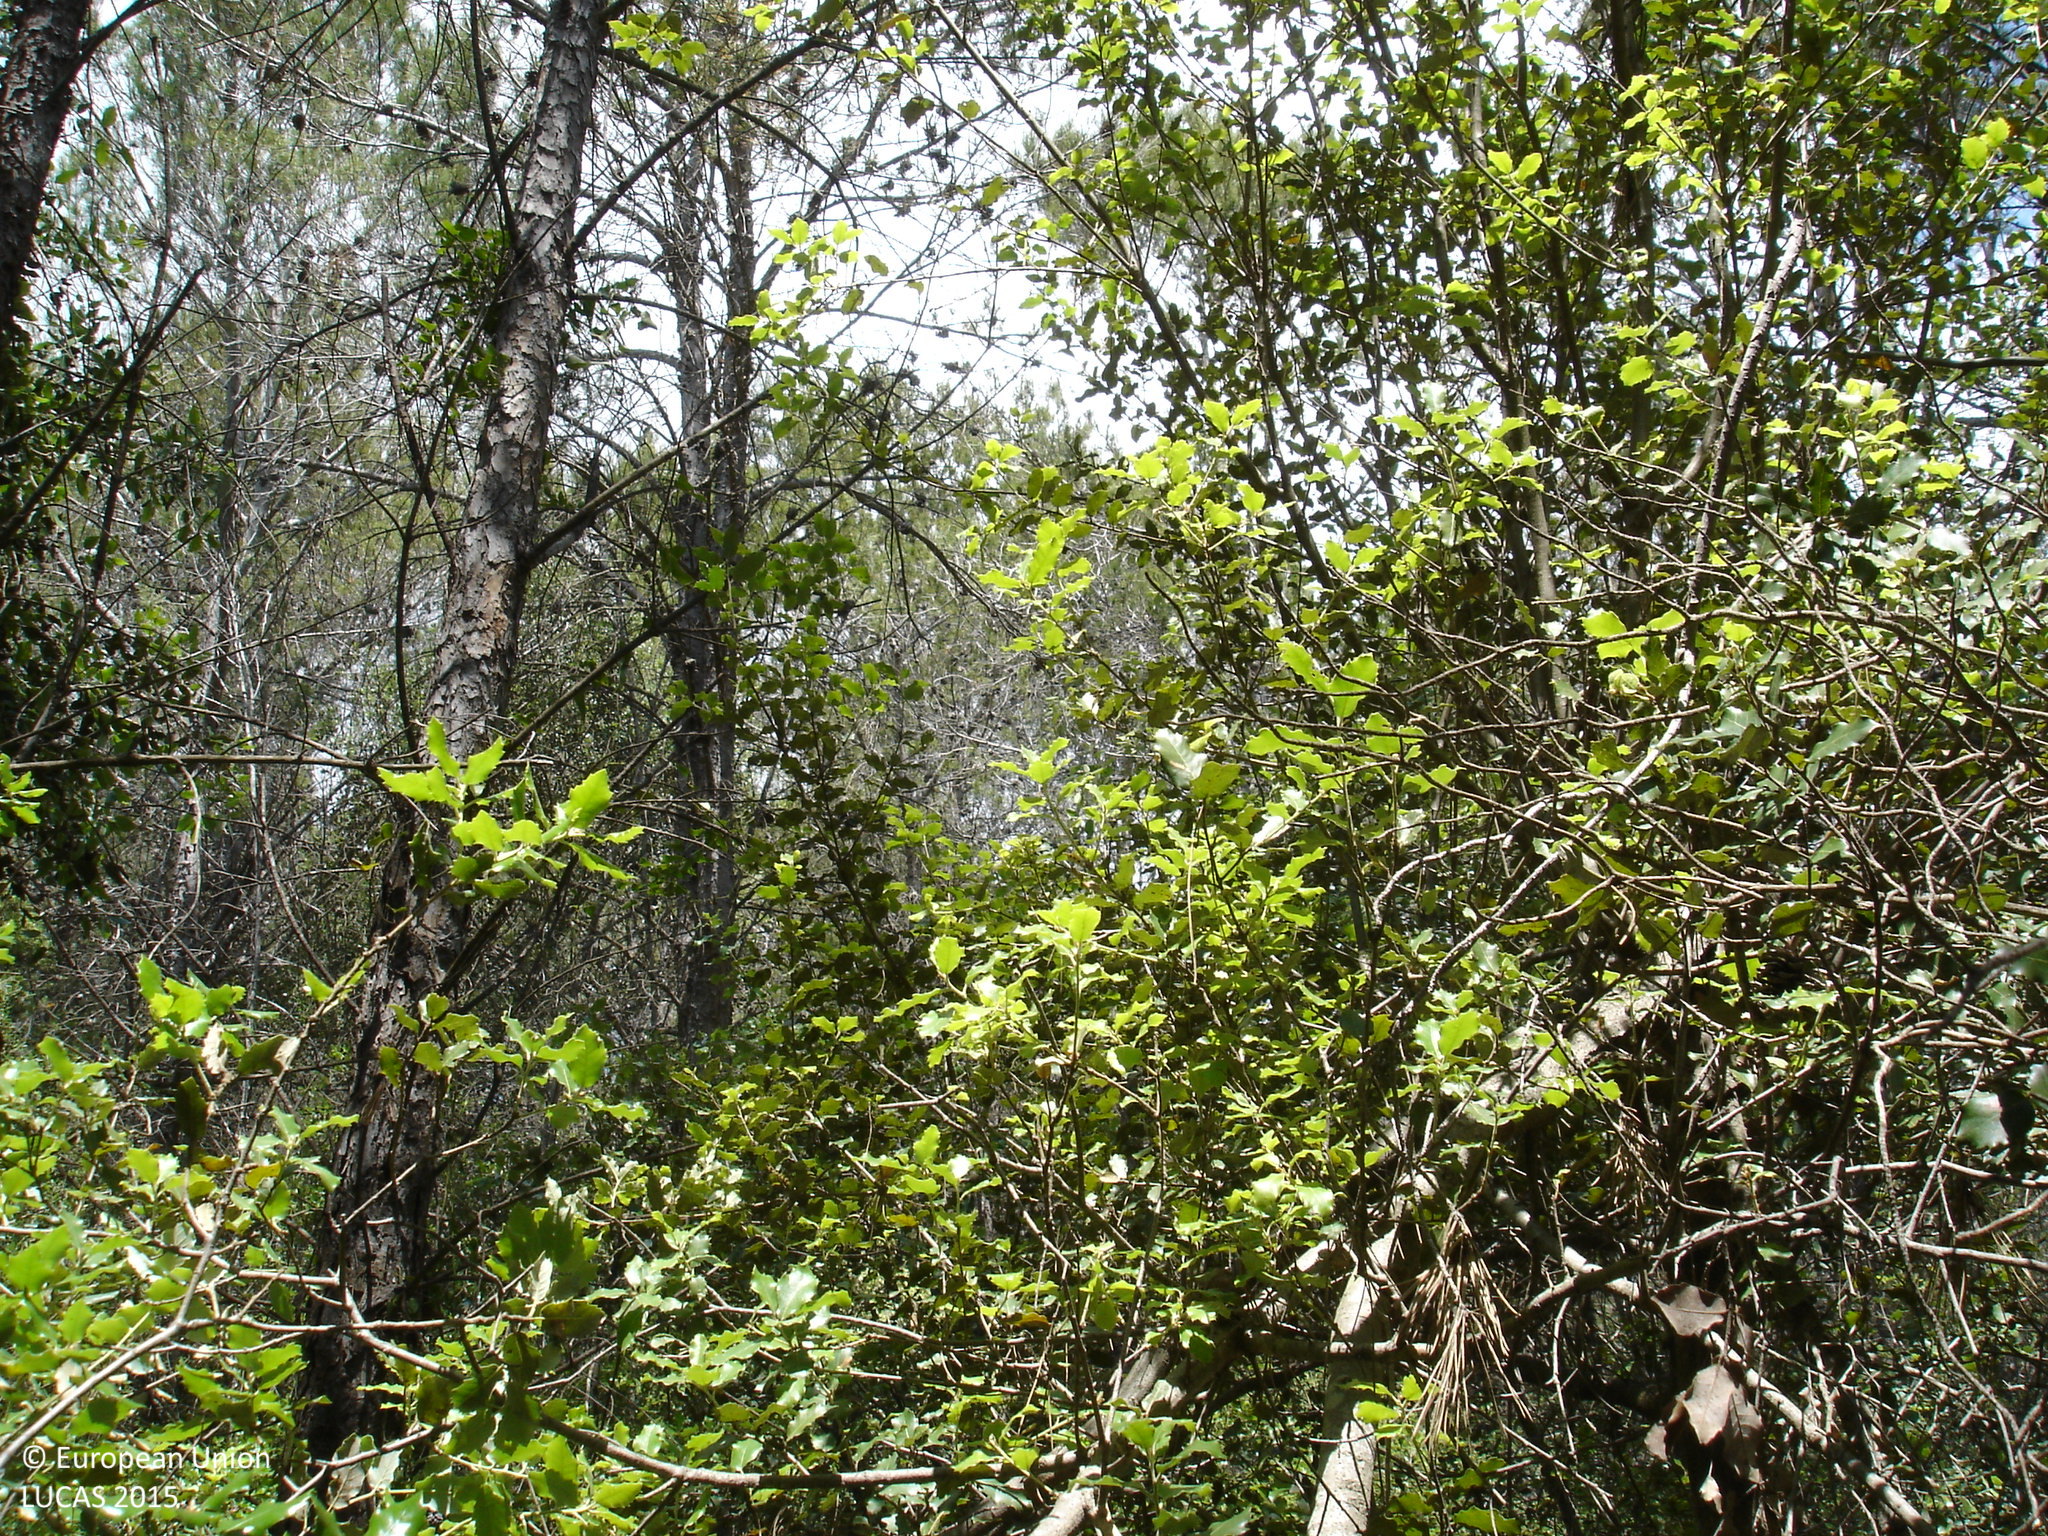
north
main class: Woodland
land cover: Pine dominated coniferous woodland
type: coniferous forest of the mediterranean region
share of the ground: > 75 %
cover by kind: coniferous forest trees 90 %, broadleaved forest trees 5 %, shrubs 5 %
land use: Forestry
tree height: > 5 m
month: May
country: ES
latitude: 42.1405
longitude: 3.0094
